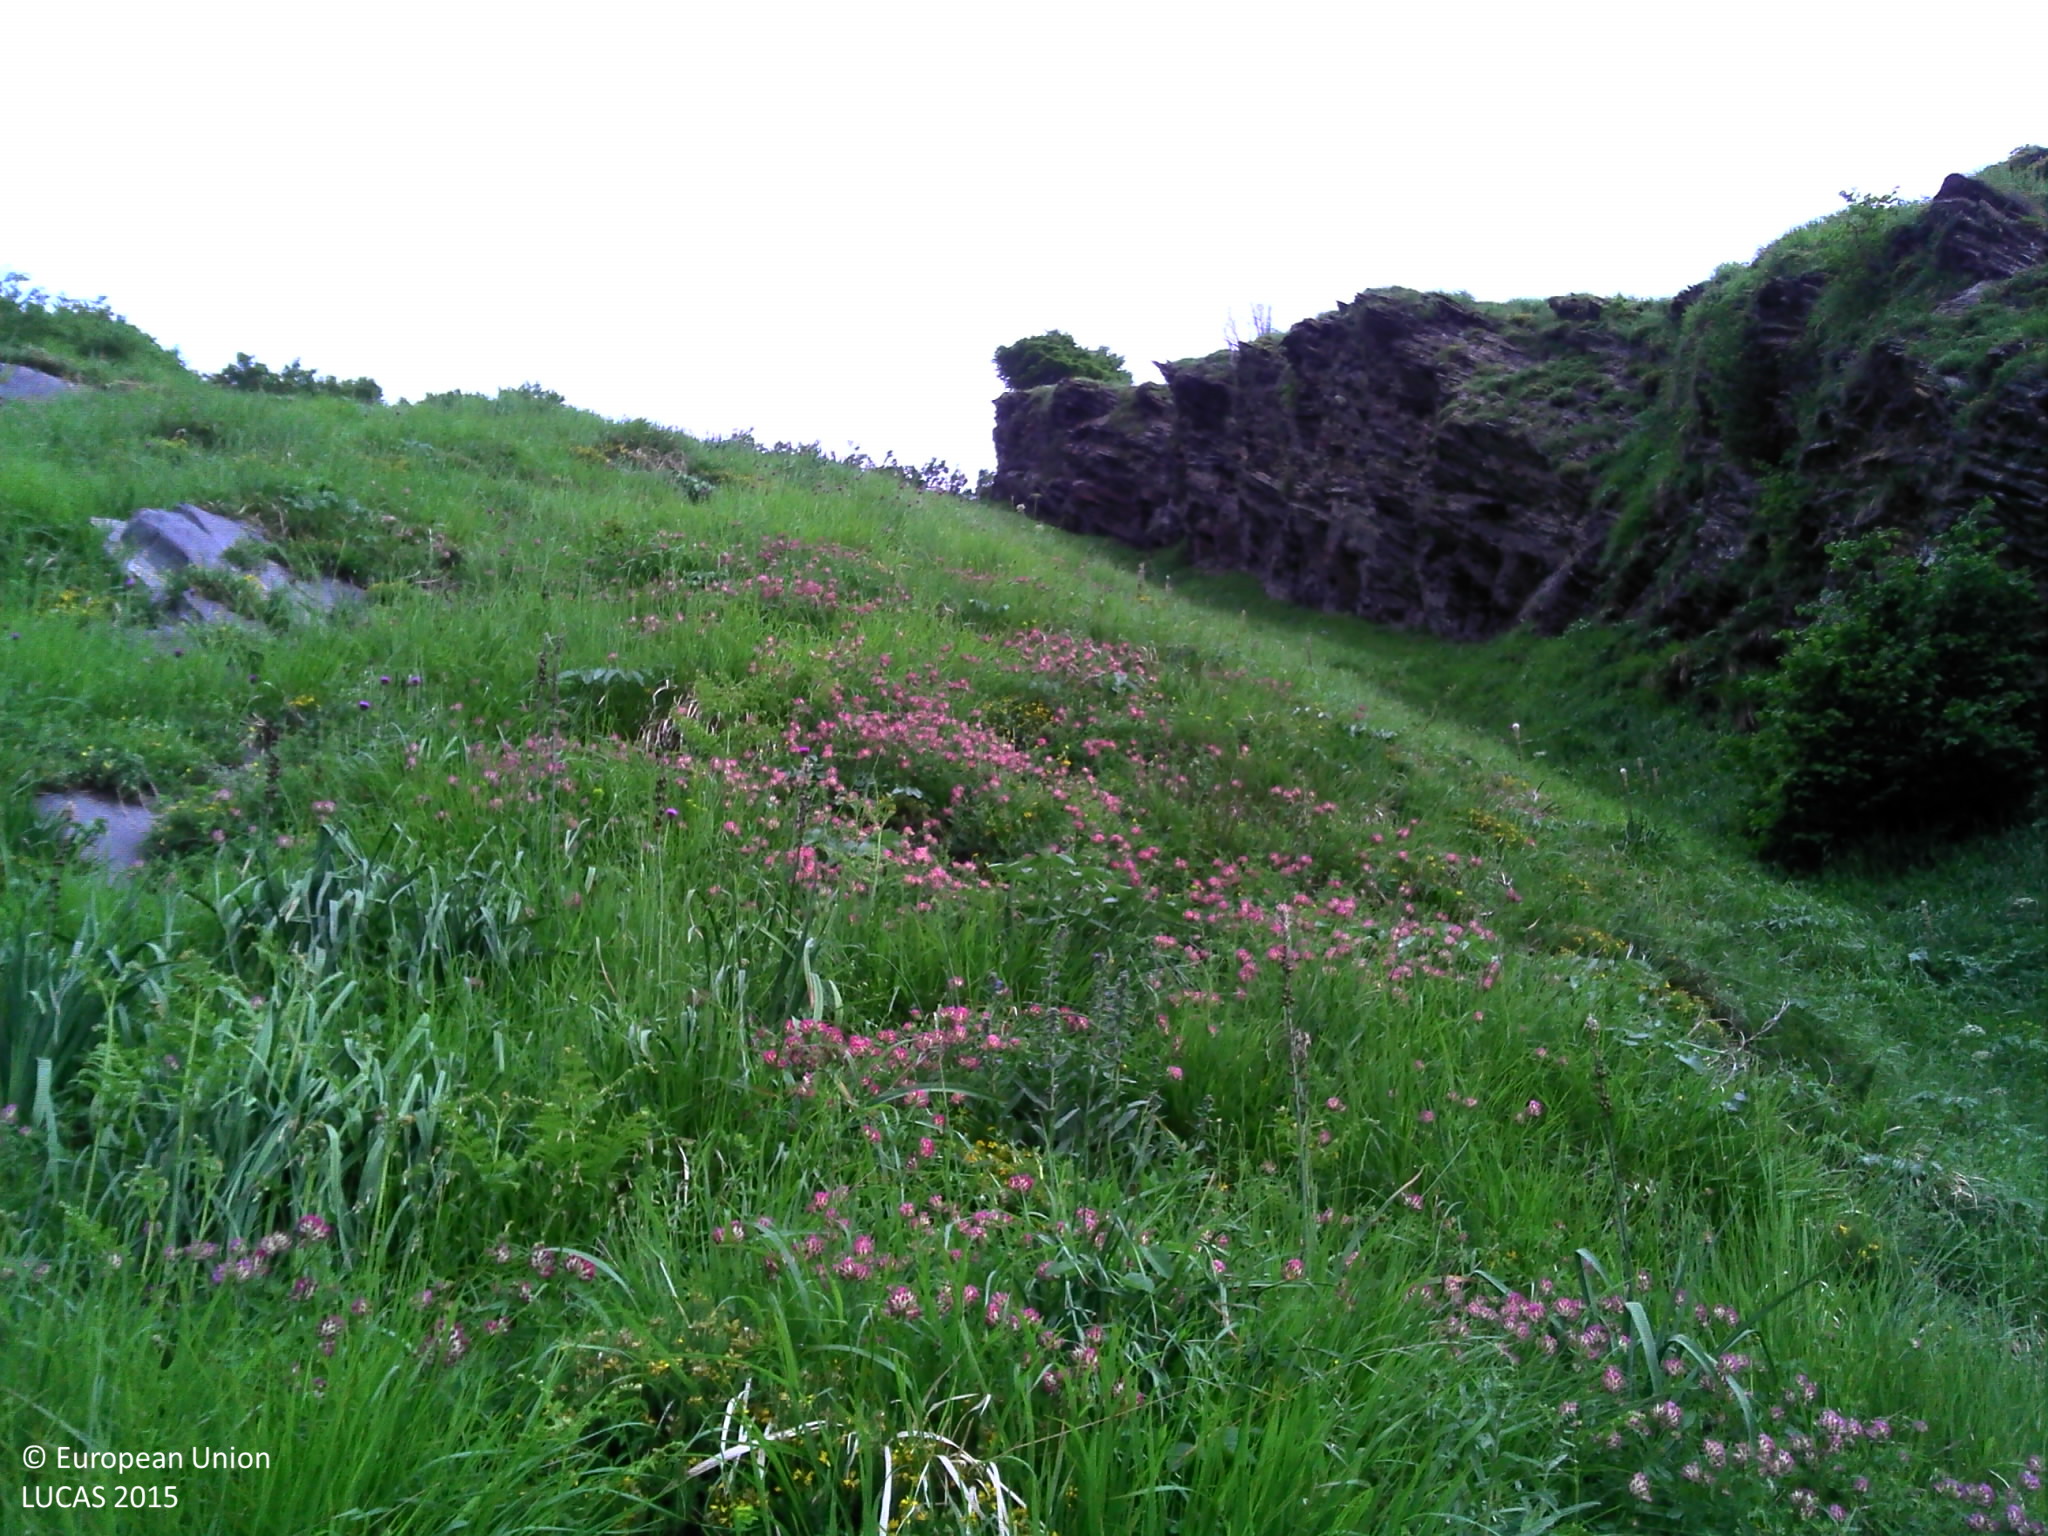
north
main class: Grassland
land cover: Grassland with sparse tree/shrub cover
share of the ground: > 75 %
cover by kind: herbaceous plants 85 %, shrubs 10 %, broadleaved forest trees 5 %
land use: Agriculture (excluding fallow land and kitchen gardens)
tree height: > 5 m
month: June
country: FR
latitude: 42.9455
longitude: -0.6569
